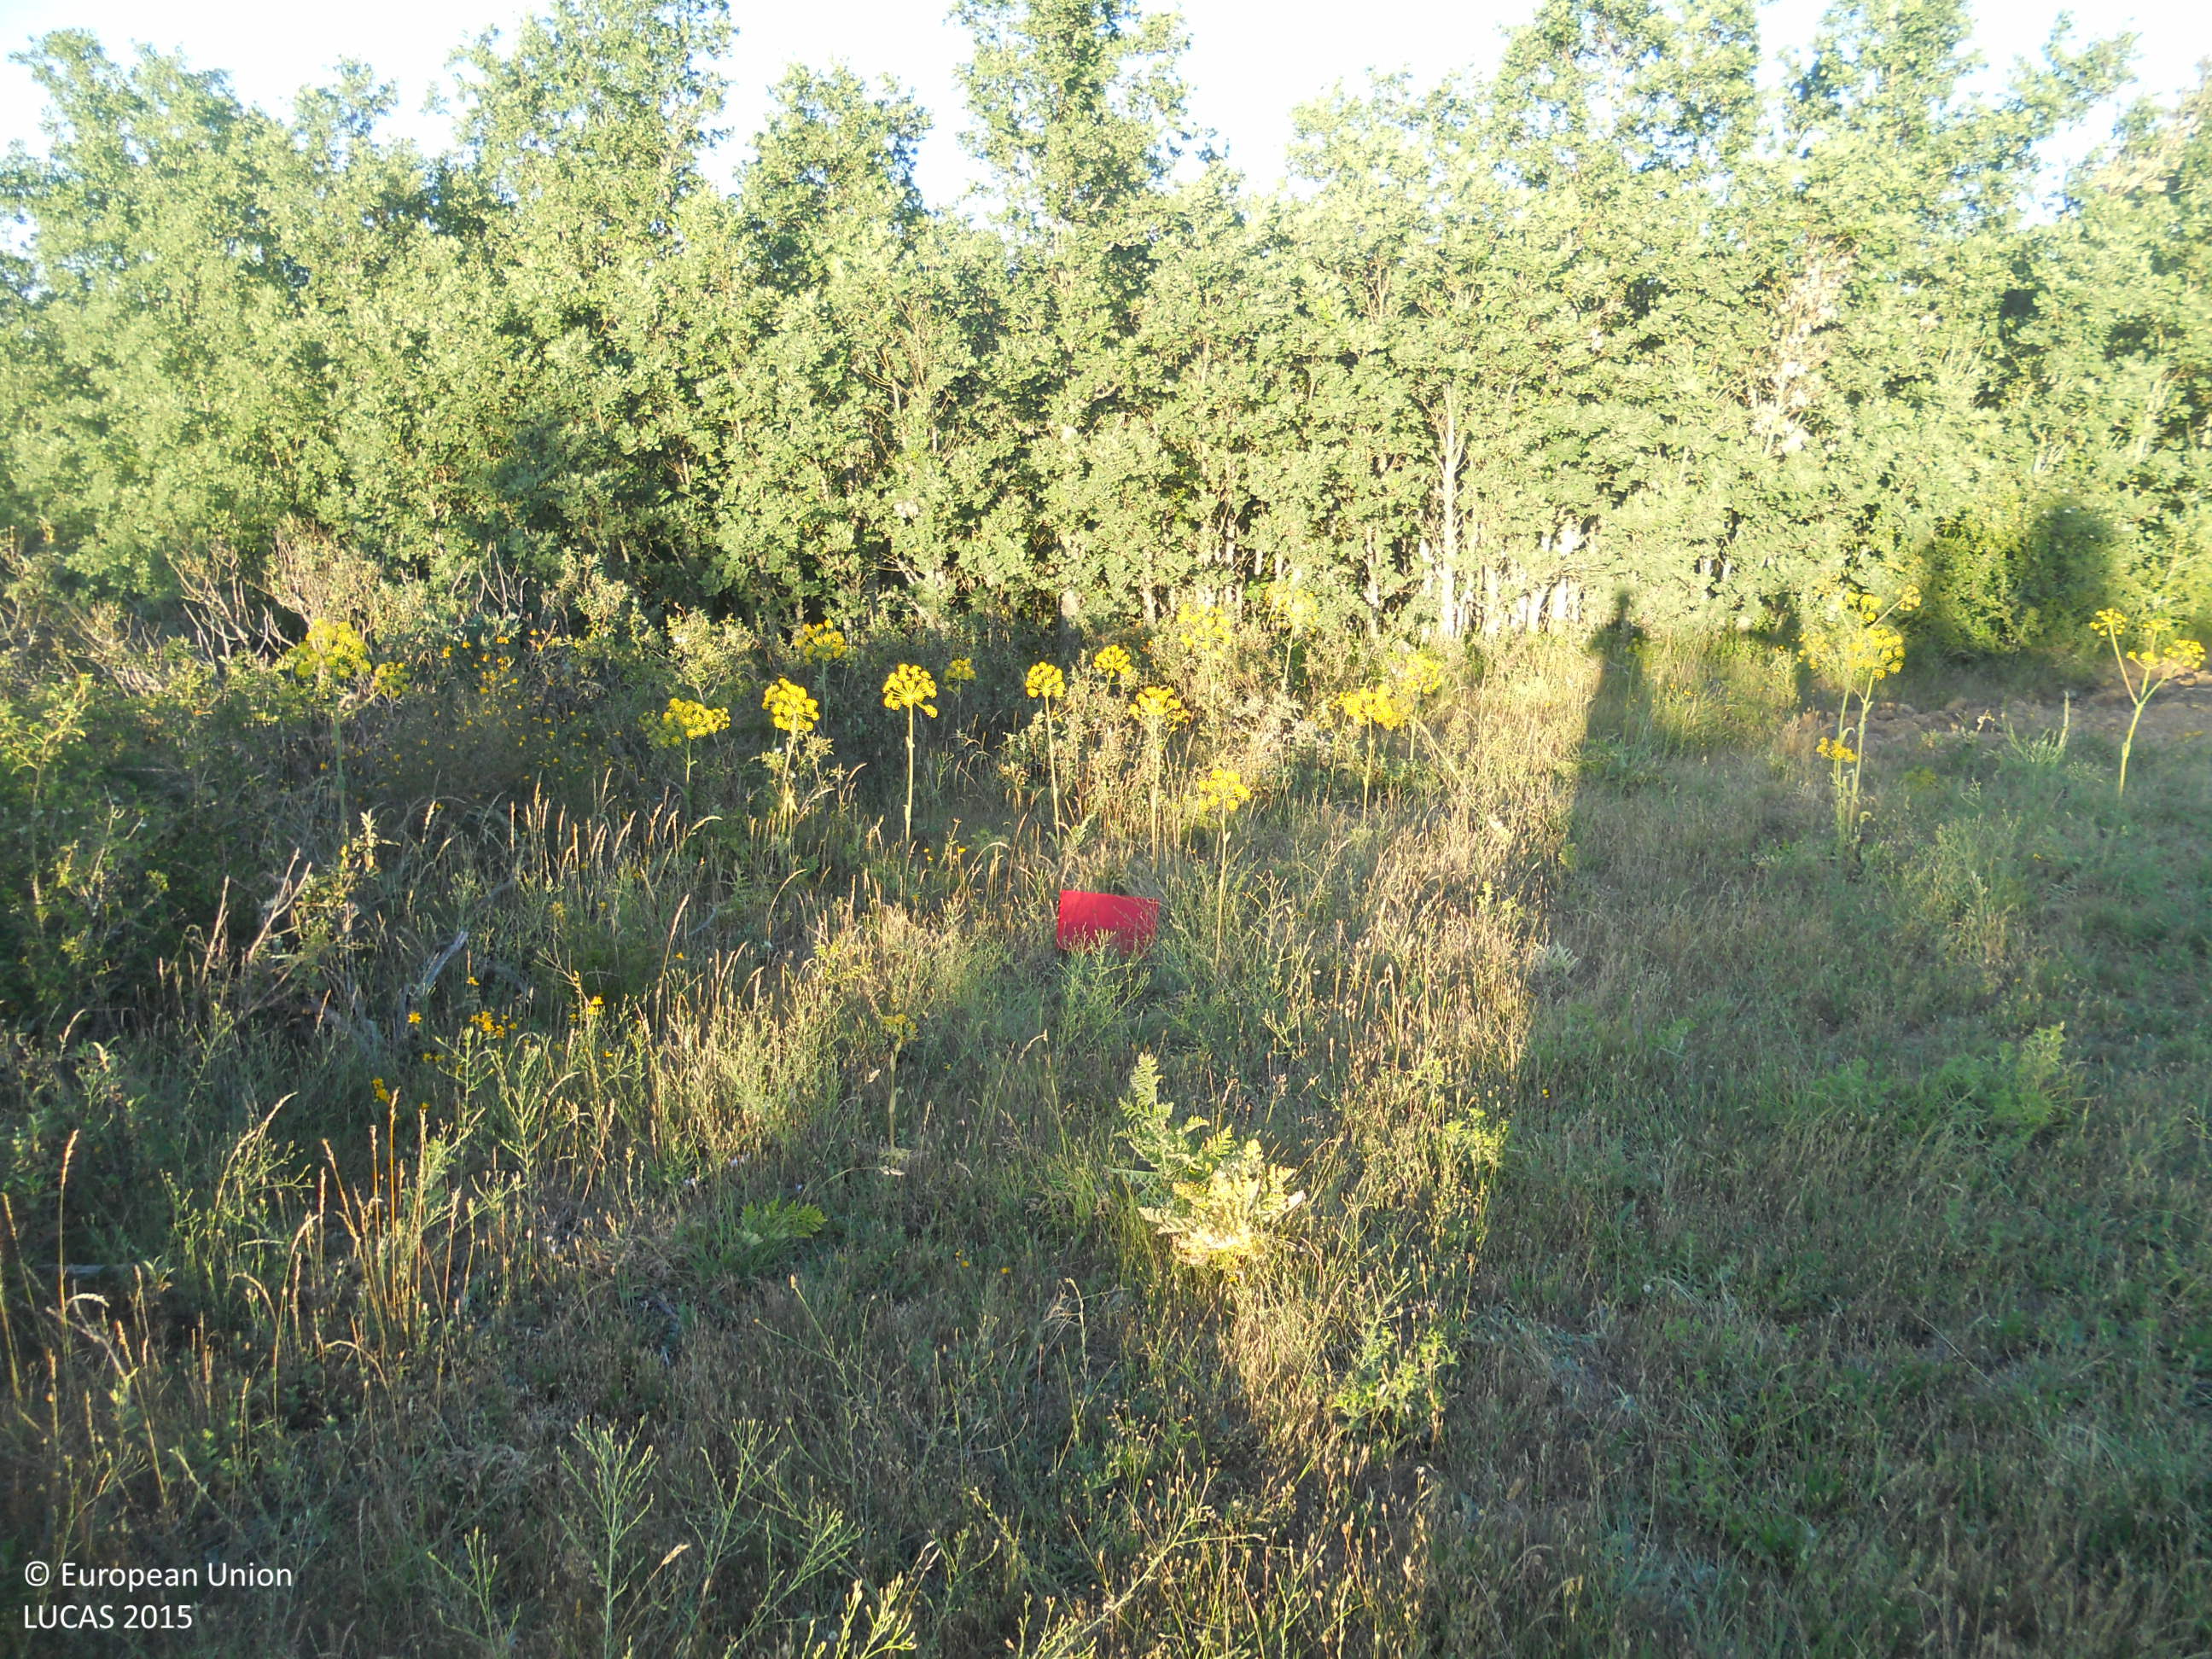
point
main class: Grassland
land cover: Grassland with sparse tree/shrub cover
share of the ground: > 75 %
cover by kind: herbaceous plants 65 %, unconsolidated bare surface 20 %, shrubs 10 %, broadleaved forest trees 5 %
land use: Semi-natural and natural areas not in use
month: June
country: ES
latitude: 42.5347
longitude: -4.9004
